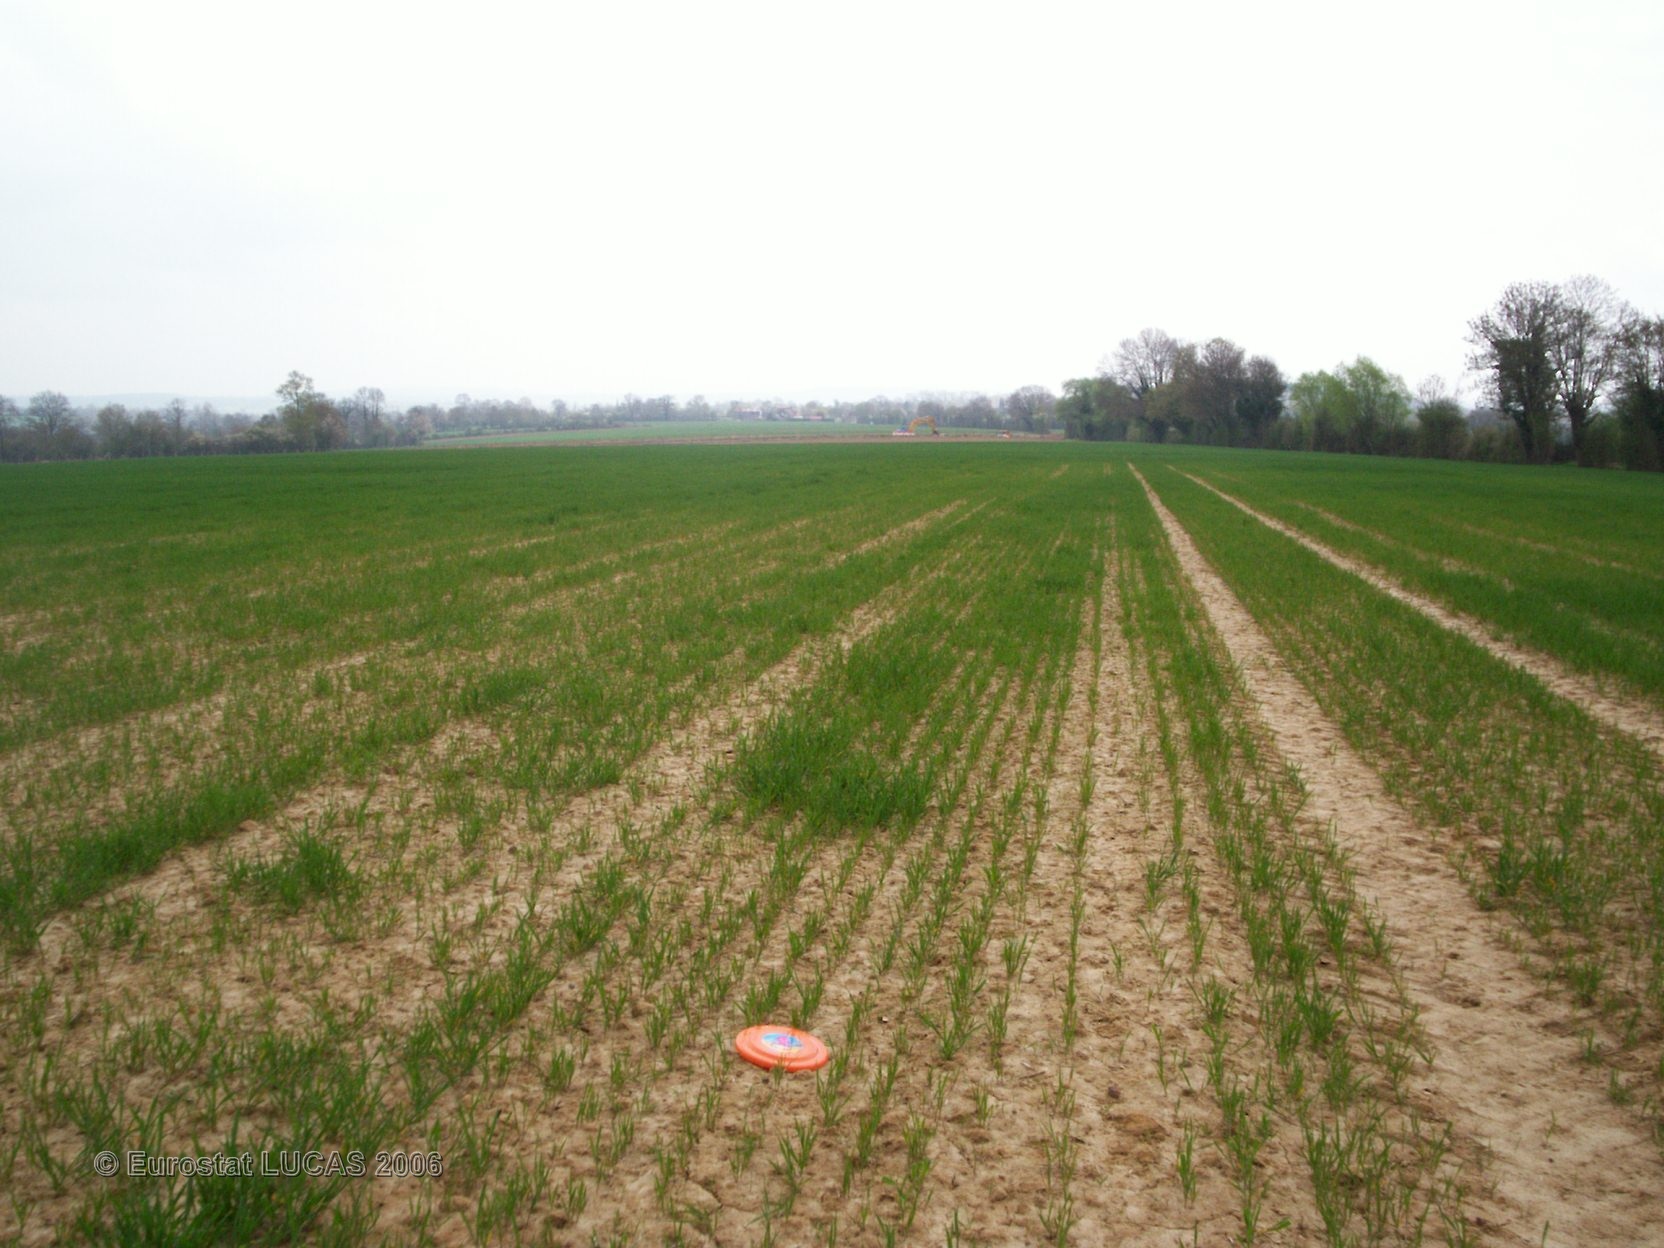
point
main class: Cropland
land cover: Common wheat
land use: Agriculture (excluding fallow land and kitchen gardens)
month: April
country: FR
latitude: 48.6780
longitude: 0.0424
